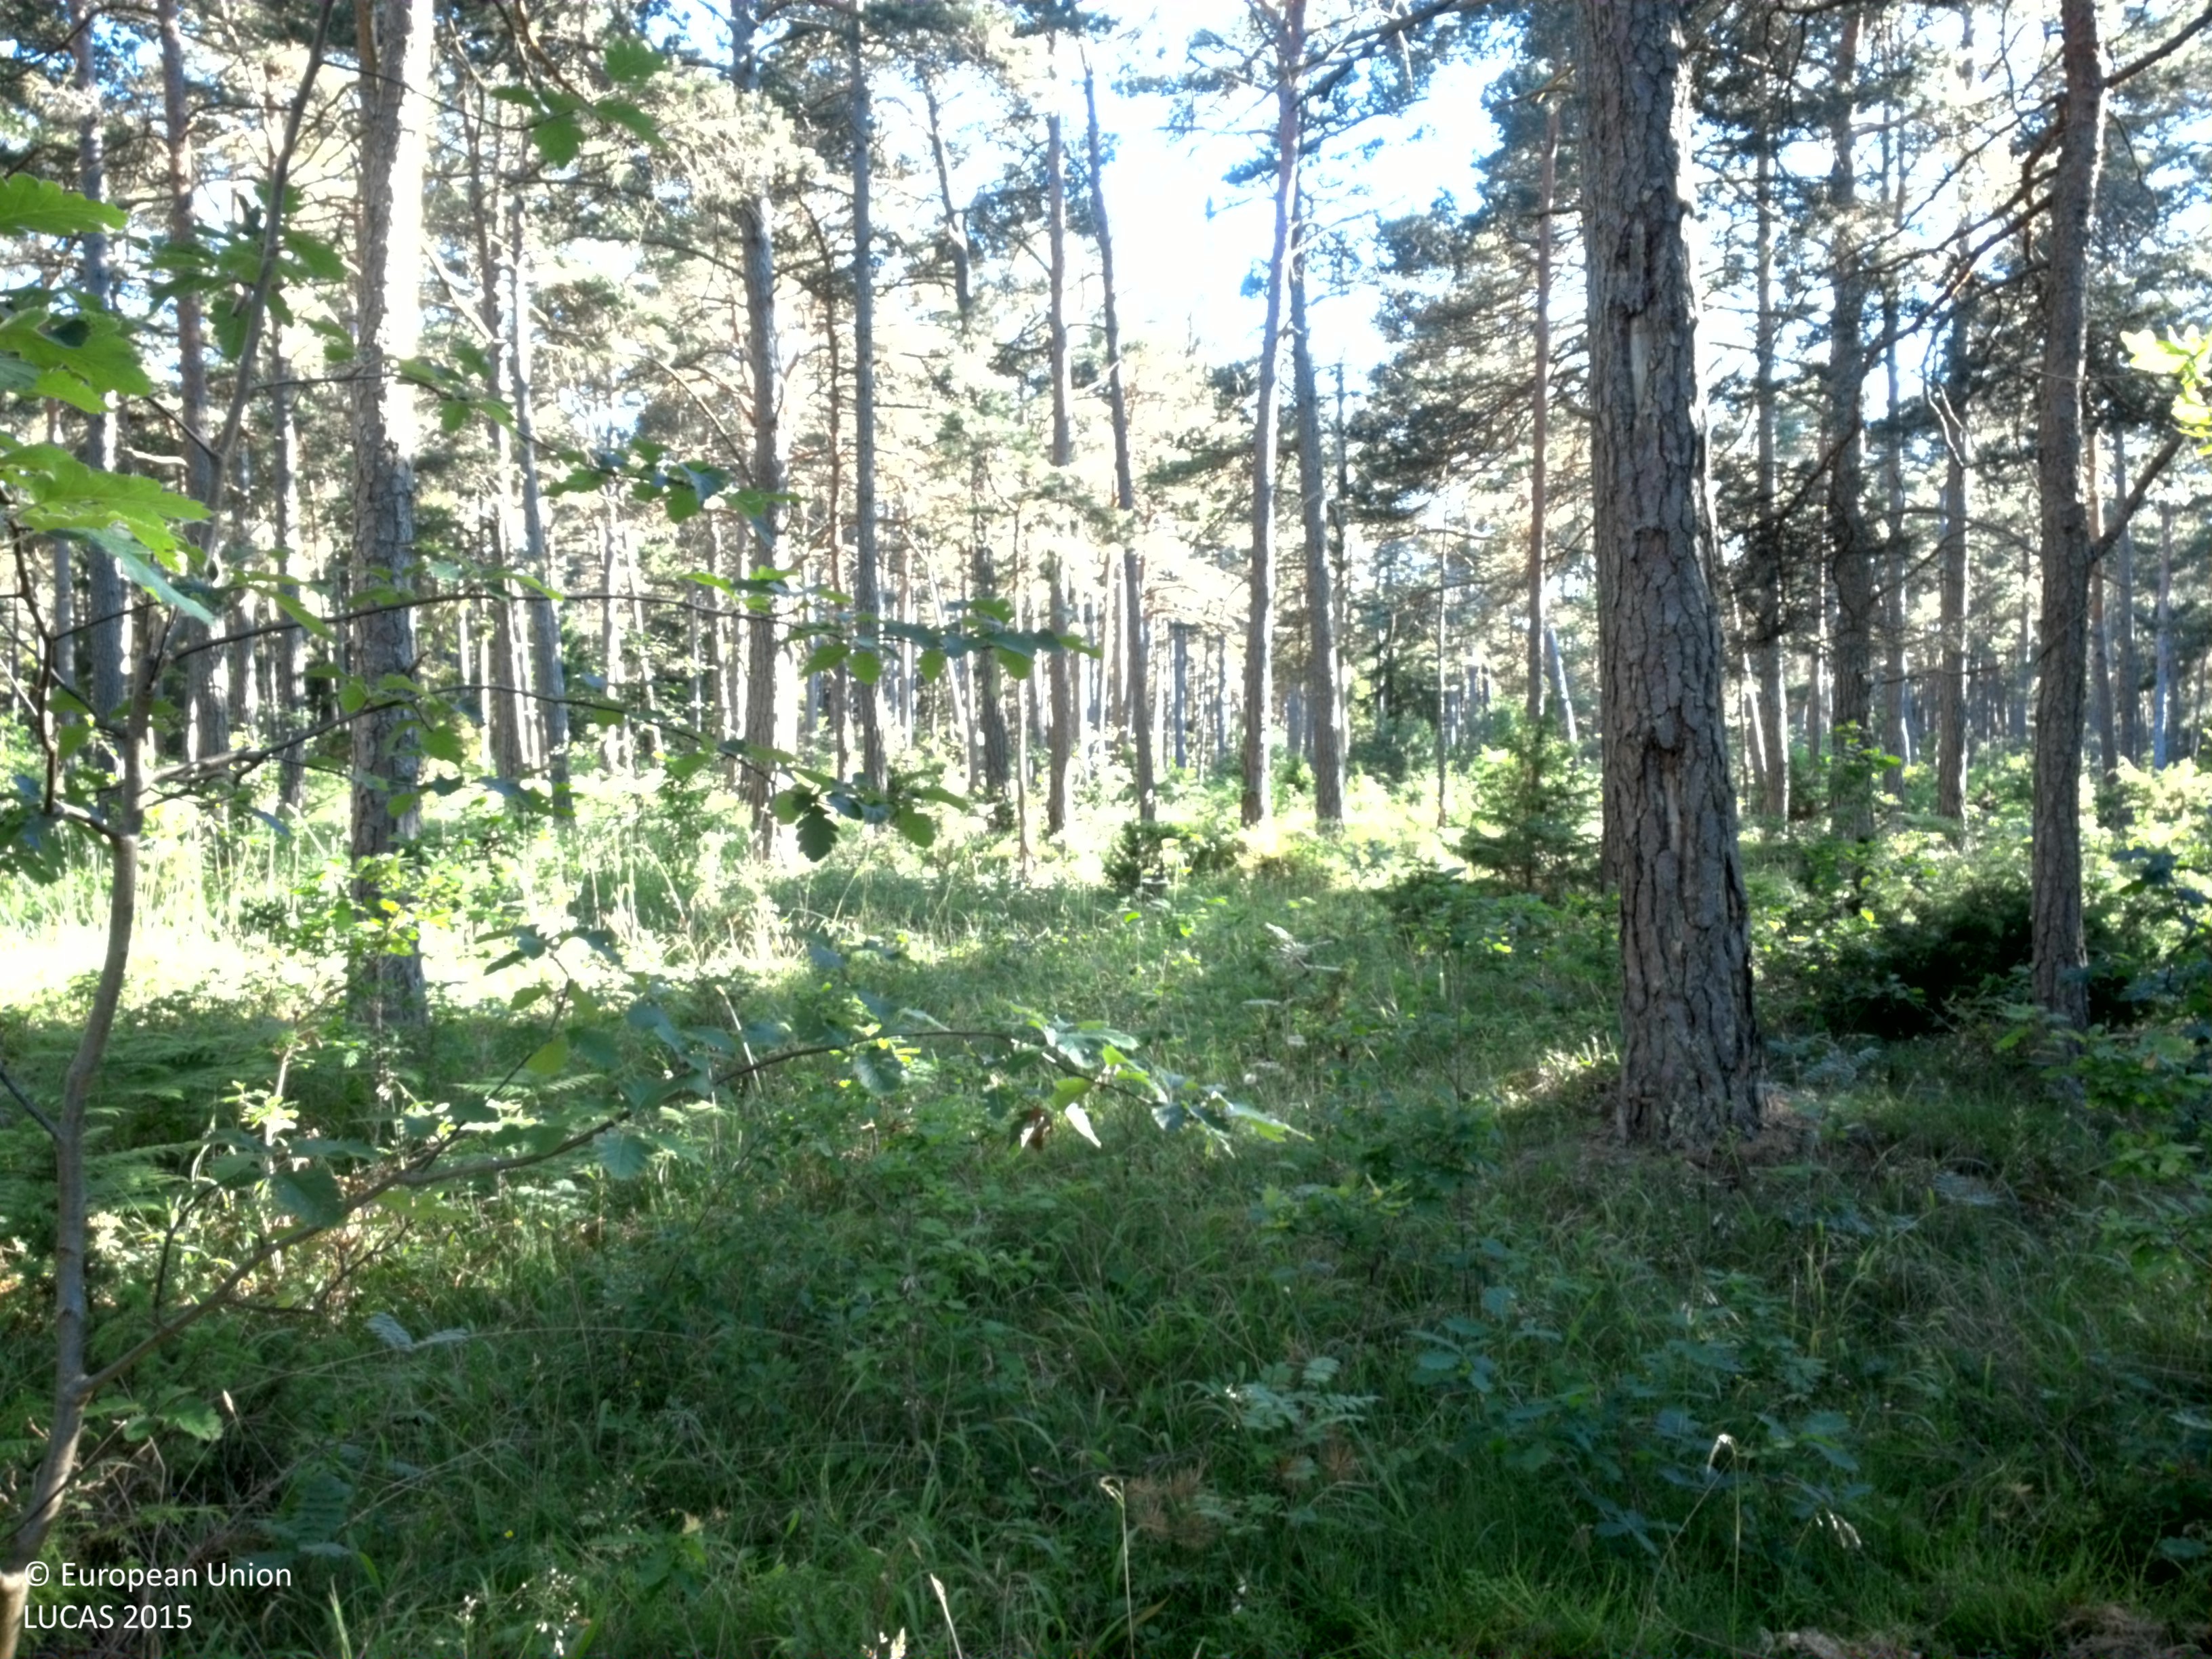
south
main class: Woodland
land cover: Pine dominated coniferous woodland
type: hemiboreal forest and nemoral coniferous forest and mixed broadleaved-coniferous forest
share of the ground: > 75 %
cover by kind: coniferous forest trees 80 %, herbaceous plants 15 %, broadleaved forest trees 5 %
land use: Forestry
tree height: > 5 m
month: July
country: SE
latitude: 57.8006
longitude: 18.5723
